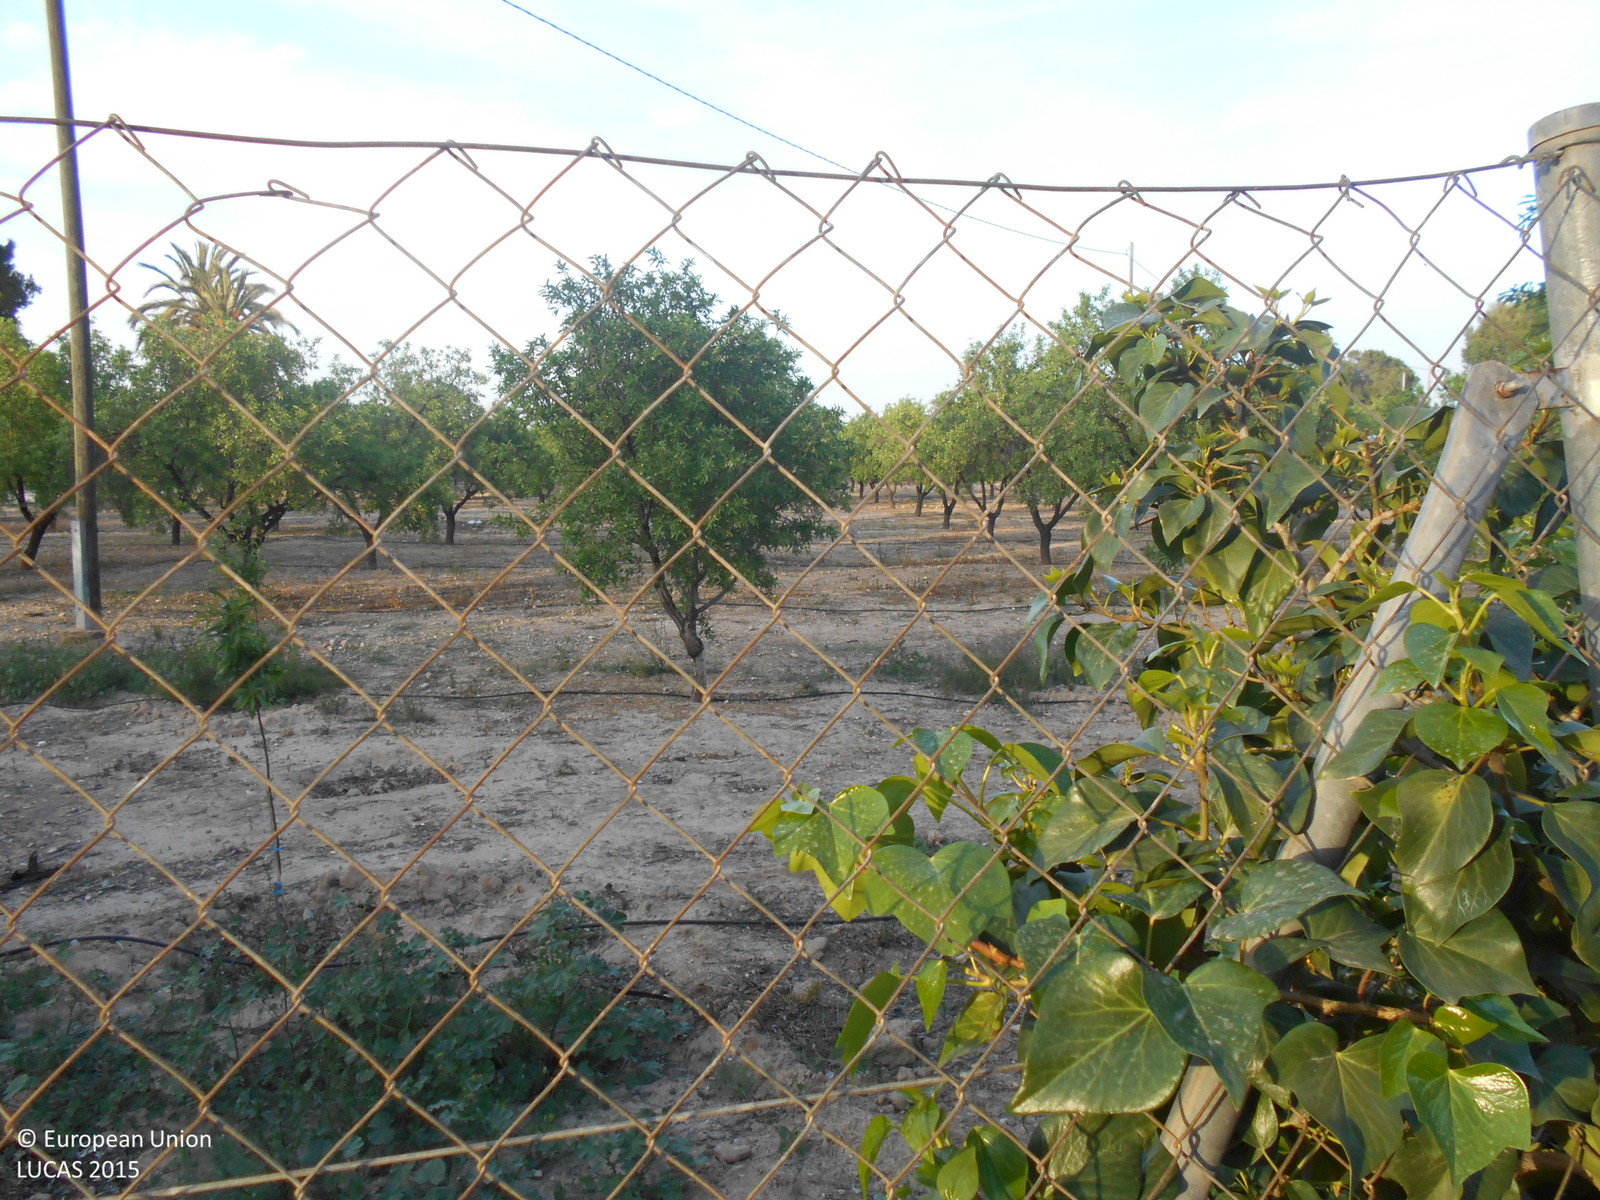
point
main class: Cropland
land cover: Nuts trees
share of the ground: 50 - 75 %
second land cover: Other bare soil
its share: > 75 %
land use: Agriculture (excluding fallow land and kitchen gardens)
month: April
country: ES
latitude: 37.7758
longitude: -1.5295
